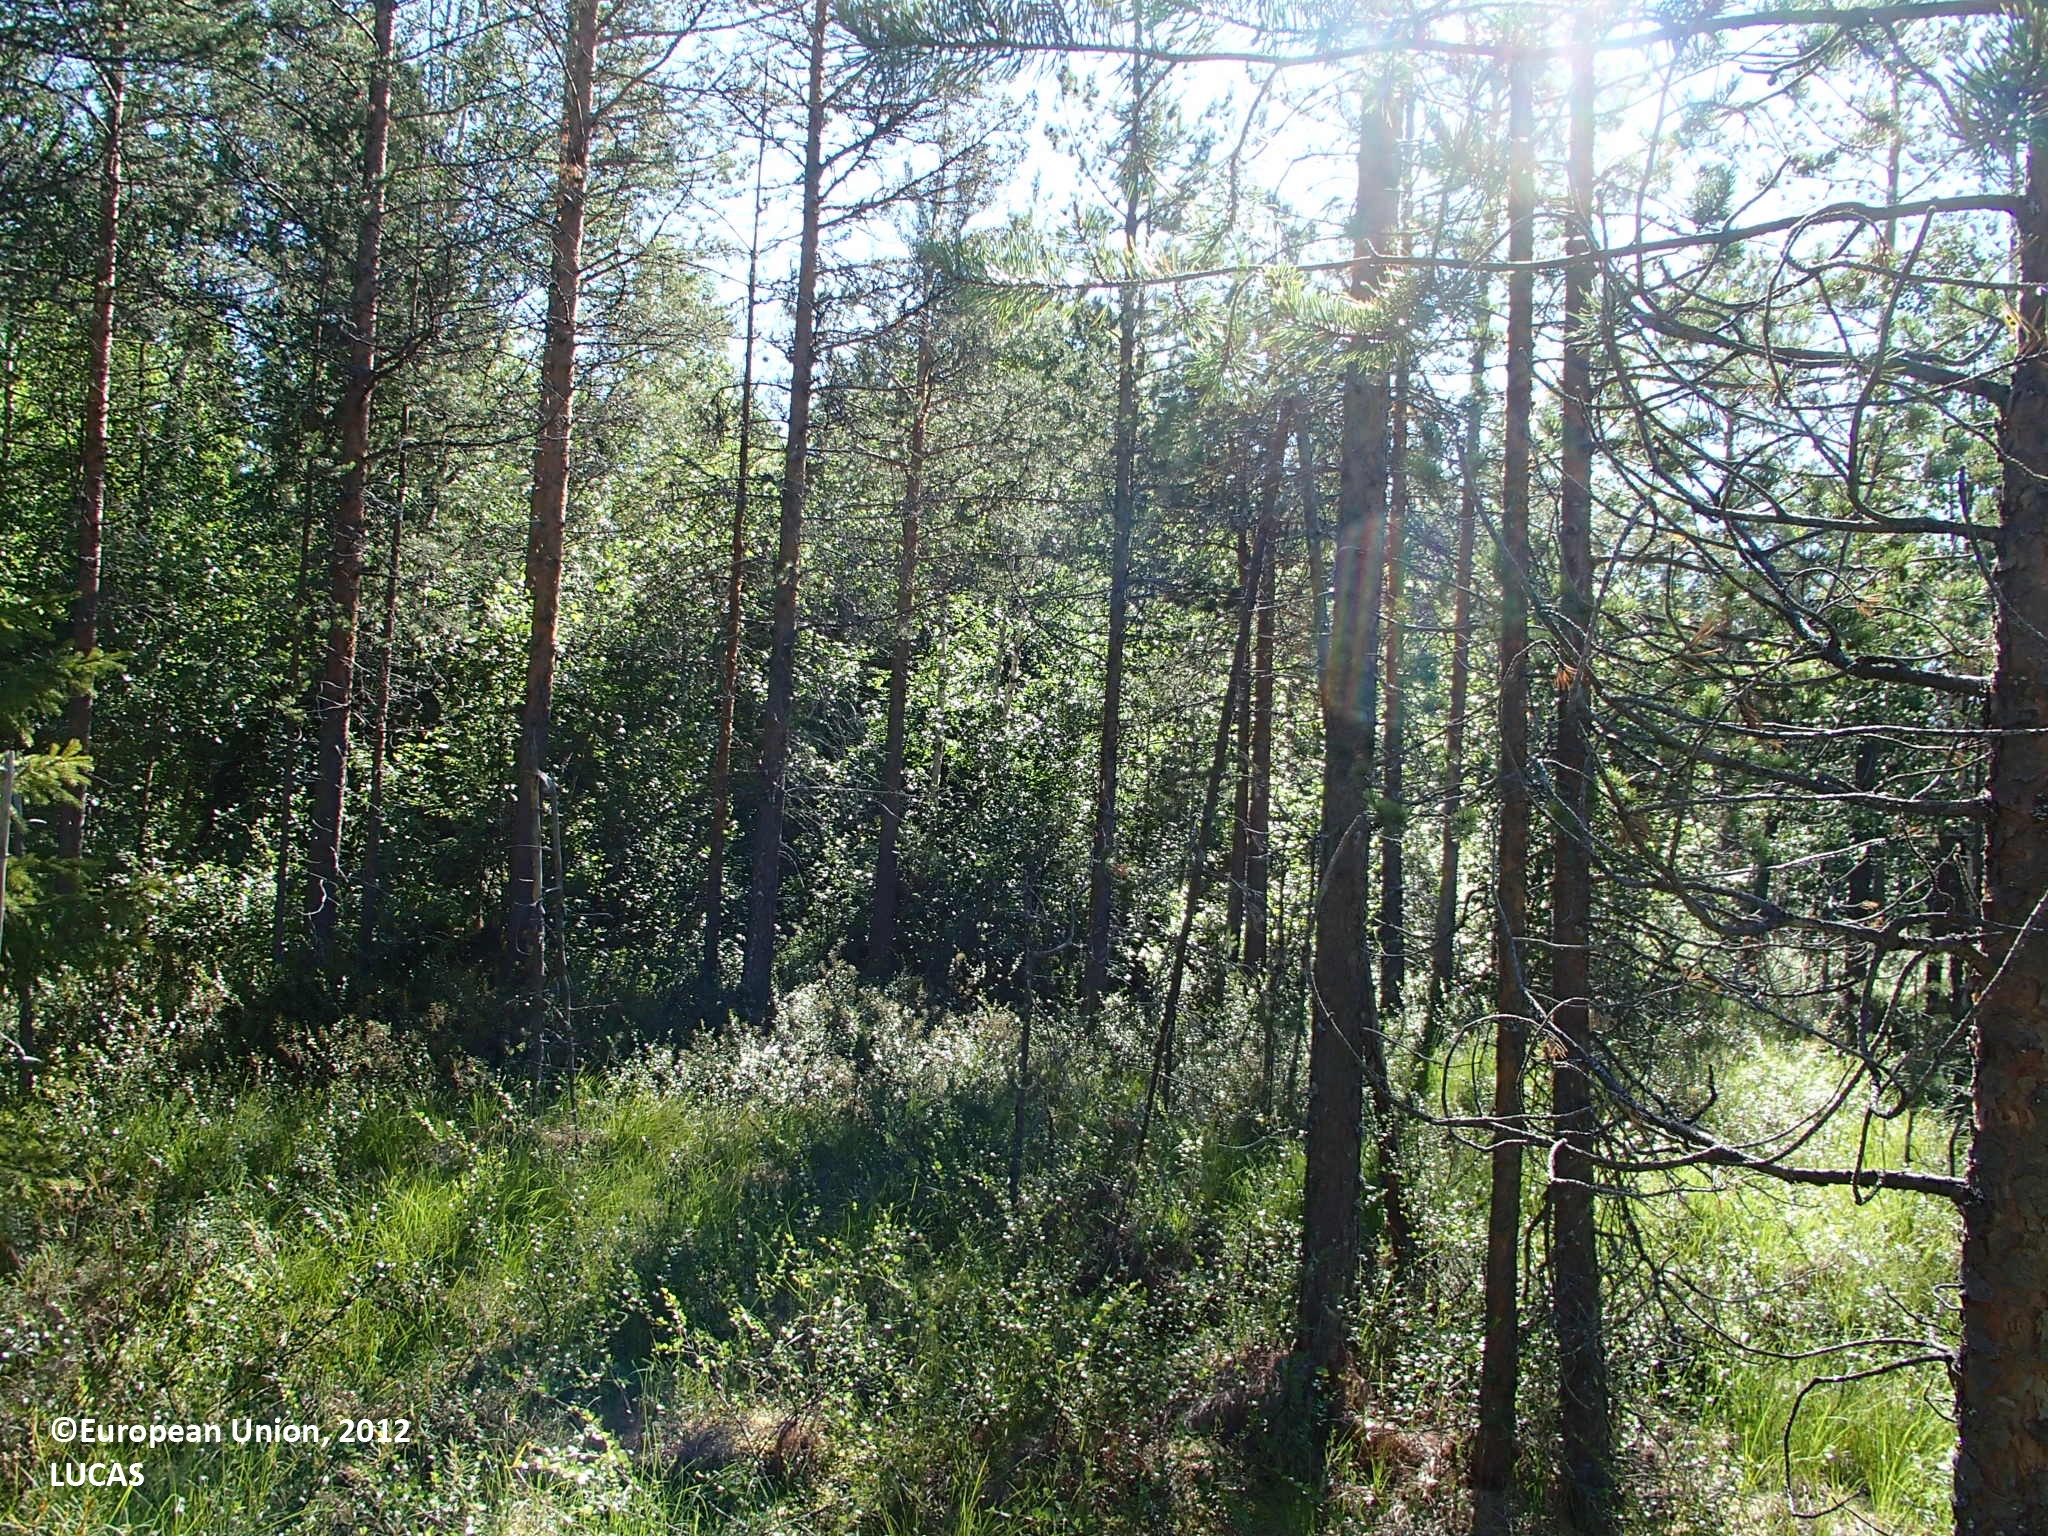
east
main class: Woodland
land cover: Pine dominated coniferous woodland
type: boreal forest
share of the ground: 25 - 50 %
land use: Forestry
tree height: > 5 m
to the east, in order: Pine dominated coniferous woodland; Other mixed woodland; Tracks; Other mixed woodland
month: July
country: FI
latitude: 66.8292
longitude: 25.3378
